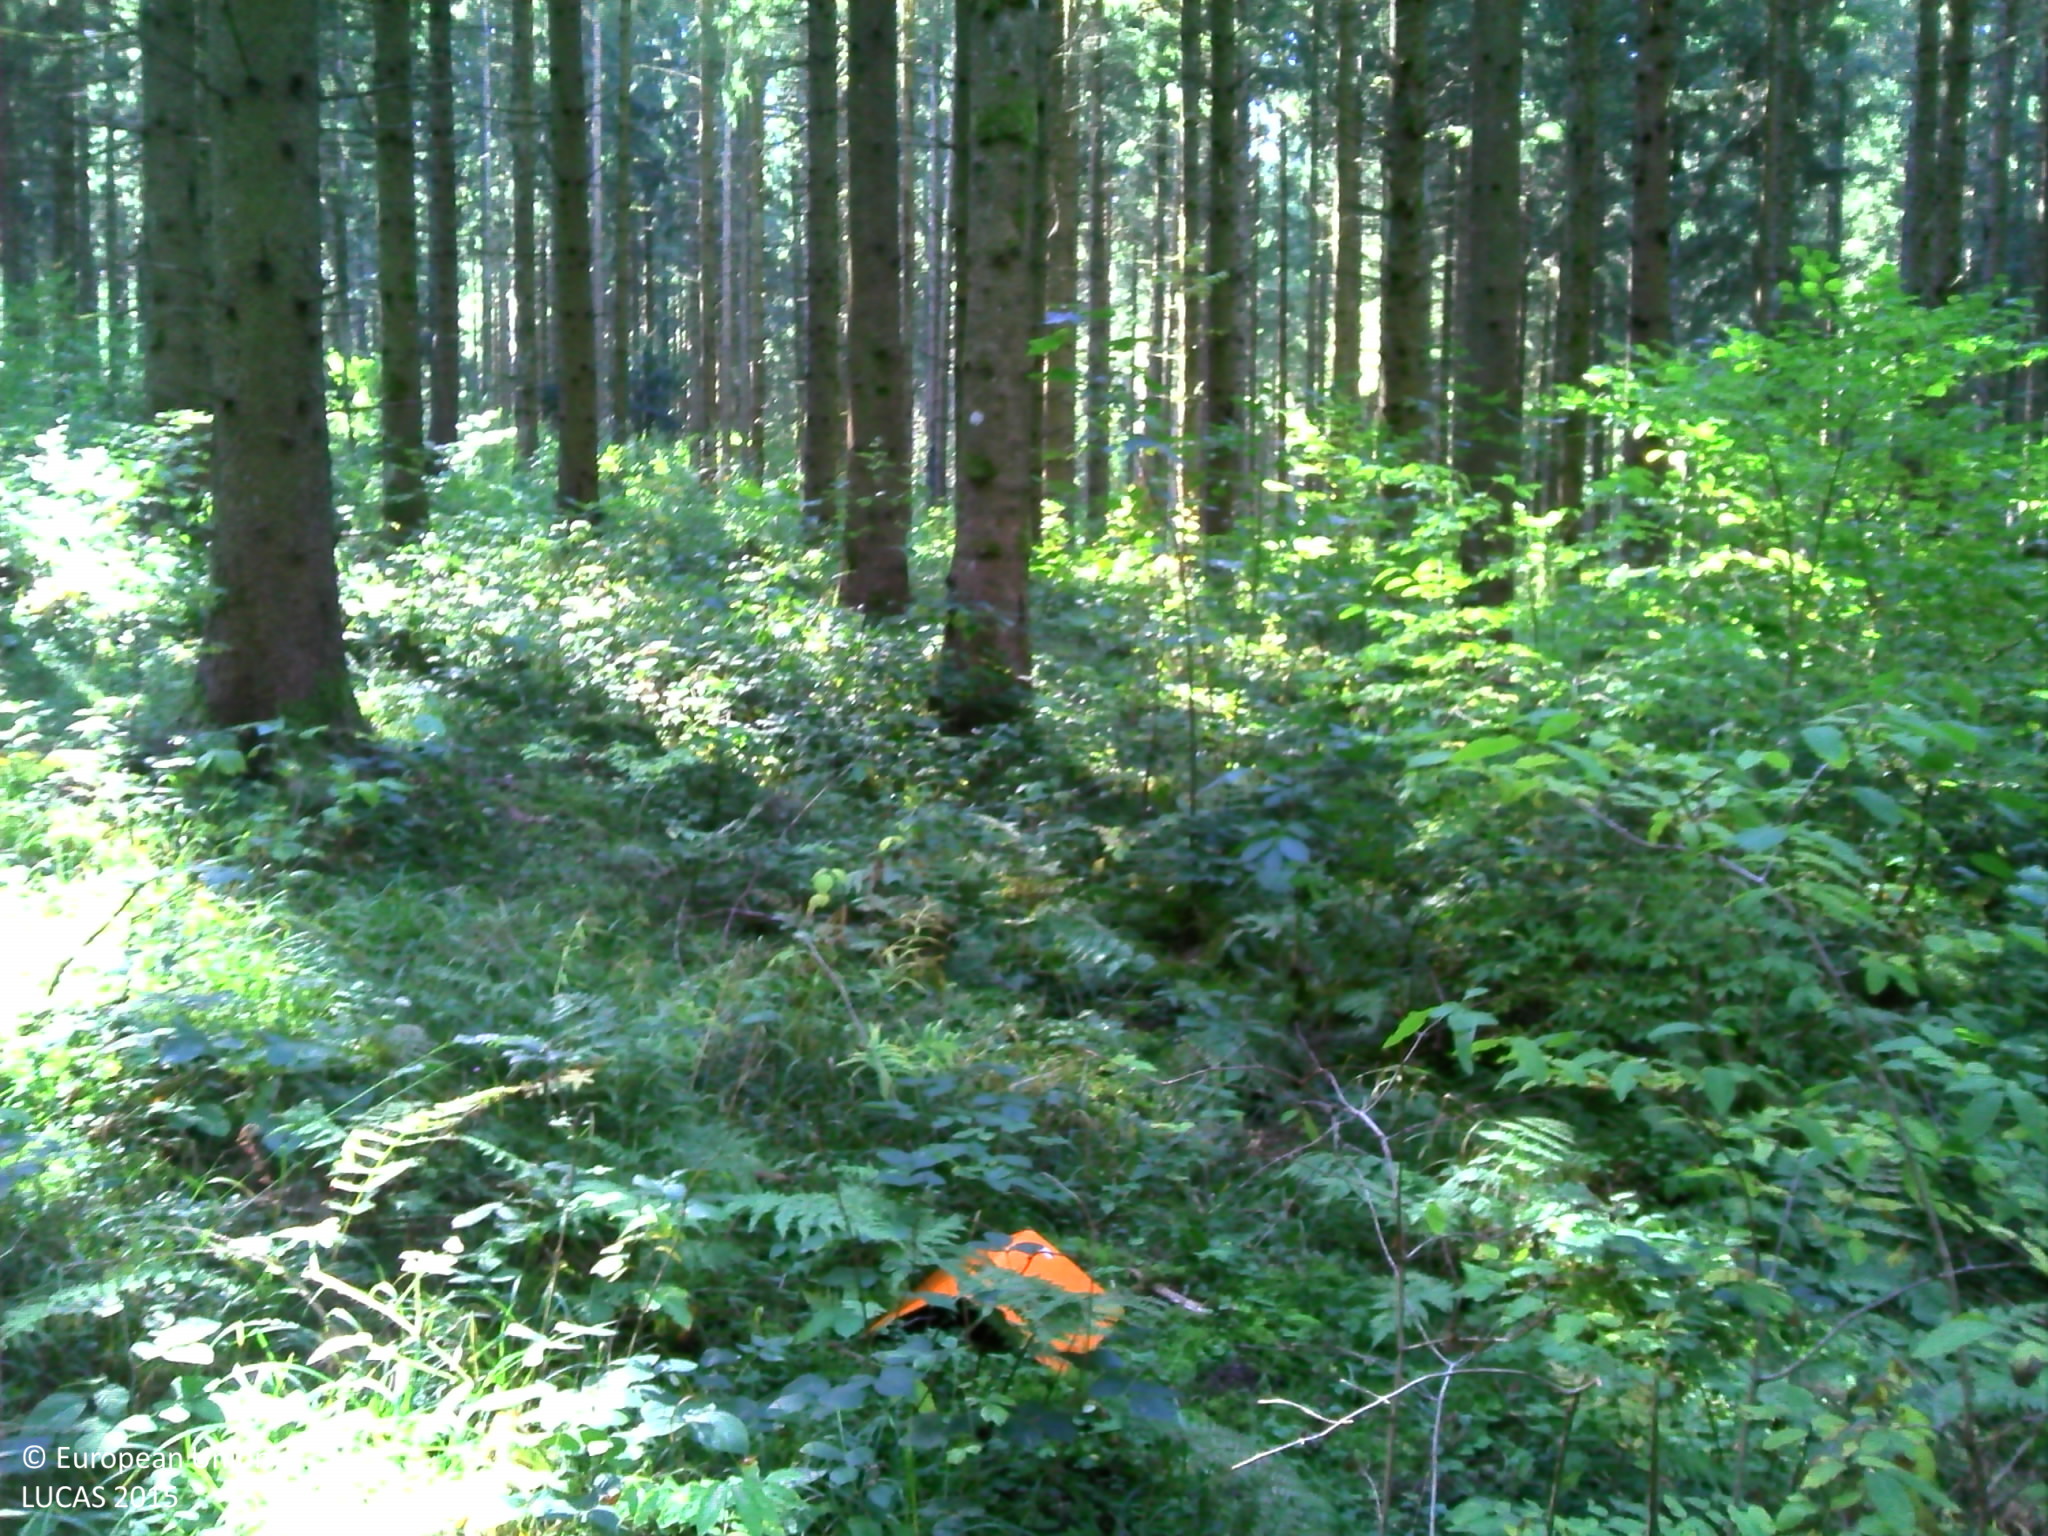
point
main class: Woodland
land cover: Spruce dominated coniferous woodland
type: exotic forest
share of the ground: > 75 %
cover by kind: coniferous forest trees 90 %, shrubs 5 %, herbaceous plants 5 %
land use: Forestry
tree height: > 5 m
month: September
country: FR
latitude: 47.1878
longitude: 6.8479
